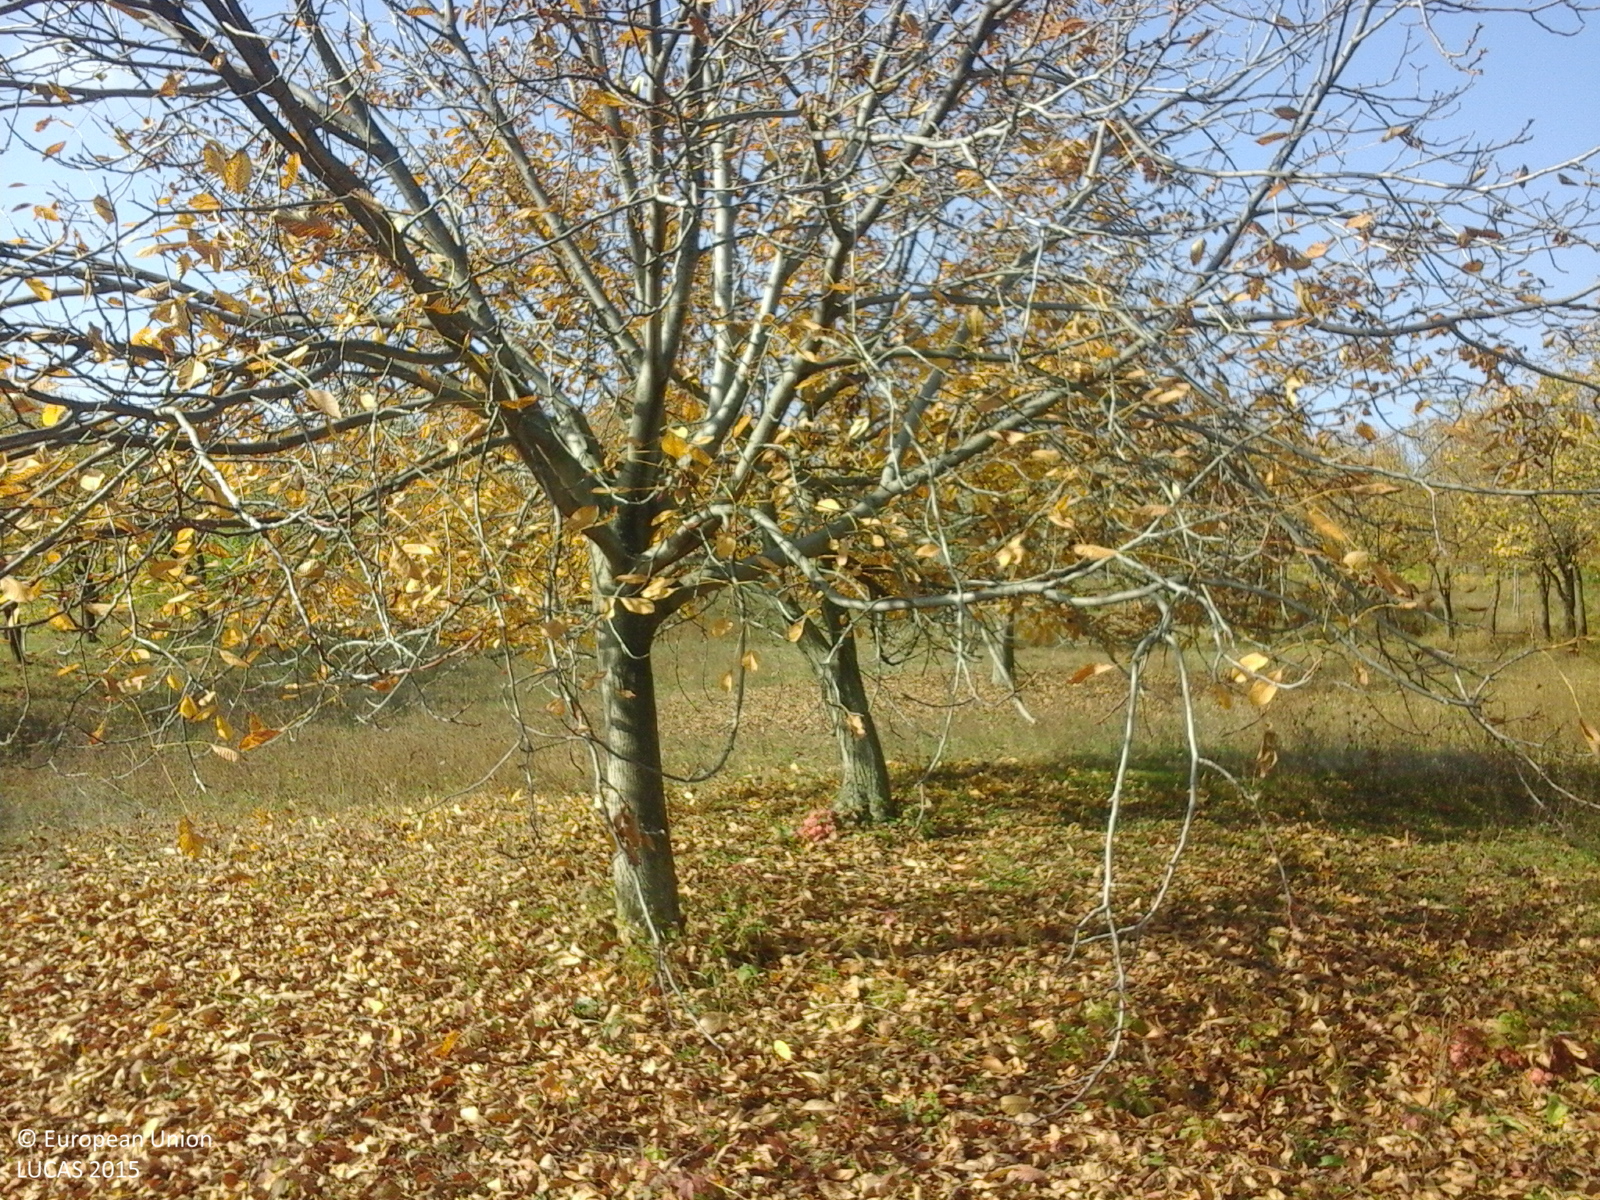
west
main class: Cropland
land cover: Nuts trees
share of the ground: > 75 %
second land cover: Grassland without tree/shrub cover
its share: > 75 %
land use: Agriculture (excluding fallow land and kitchen gardens)
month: October
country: RO
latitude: 45.6594
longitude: 26.9913
